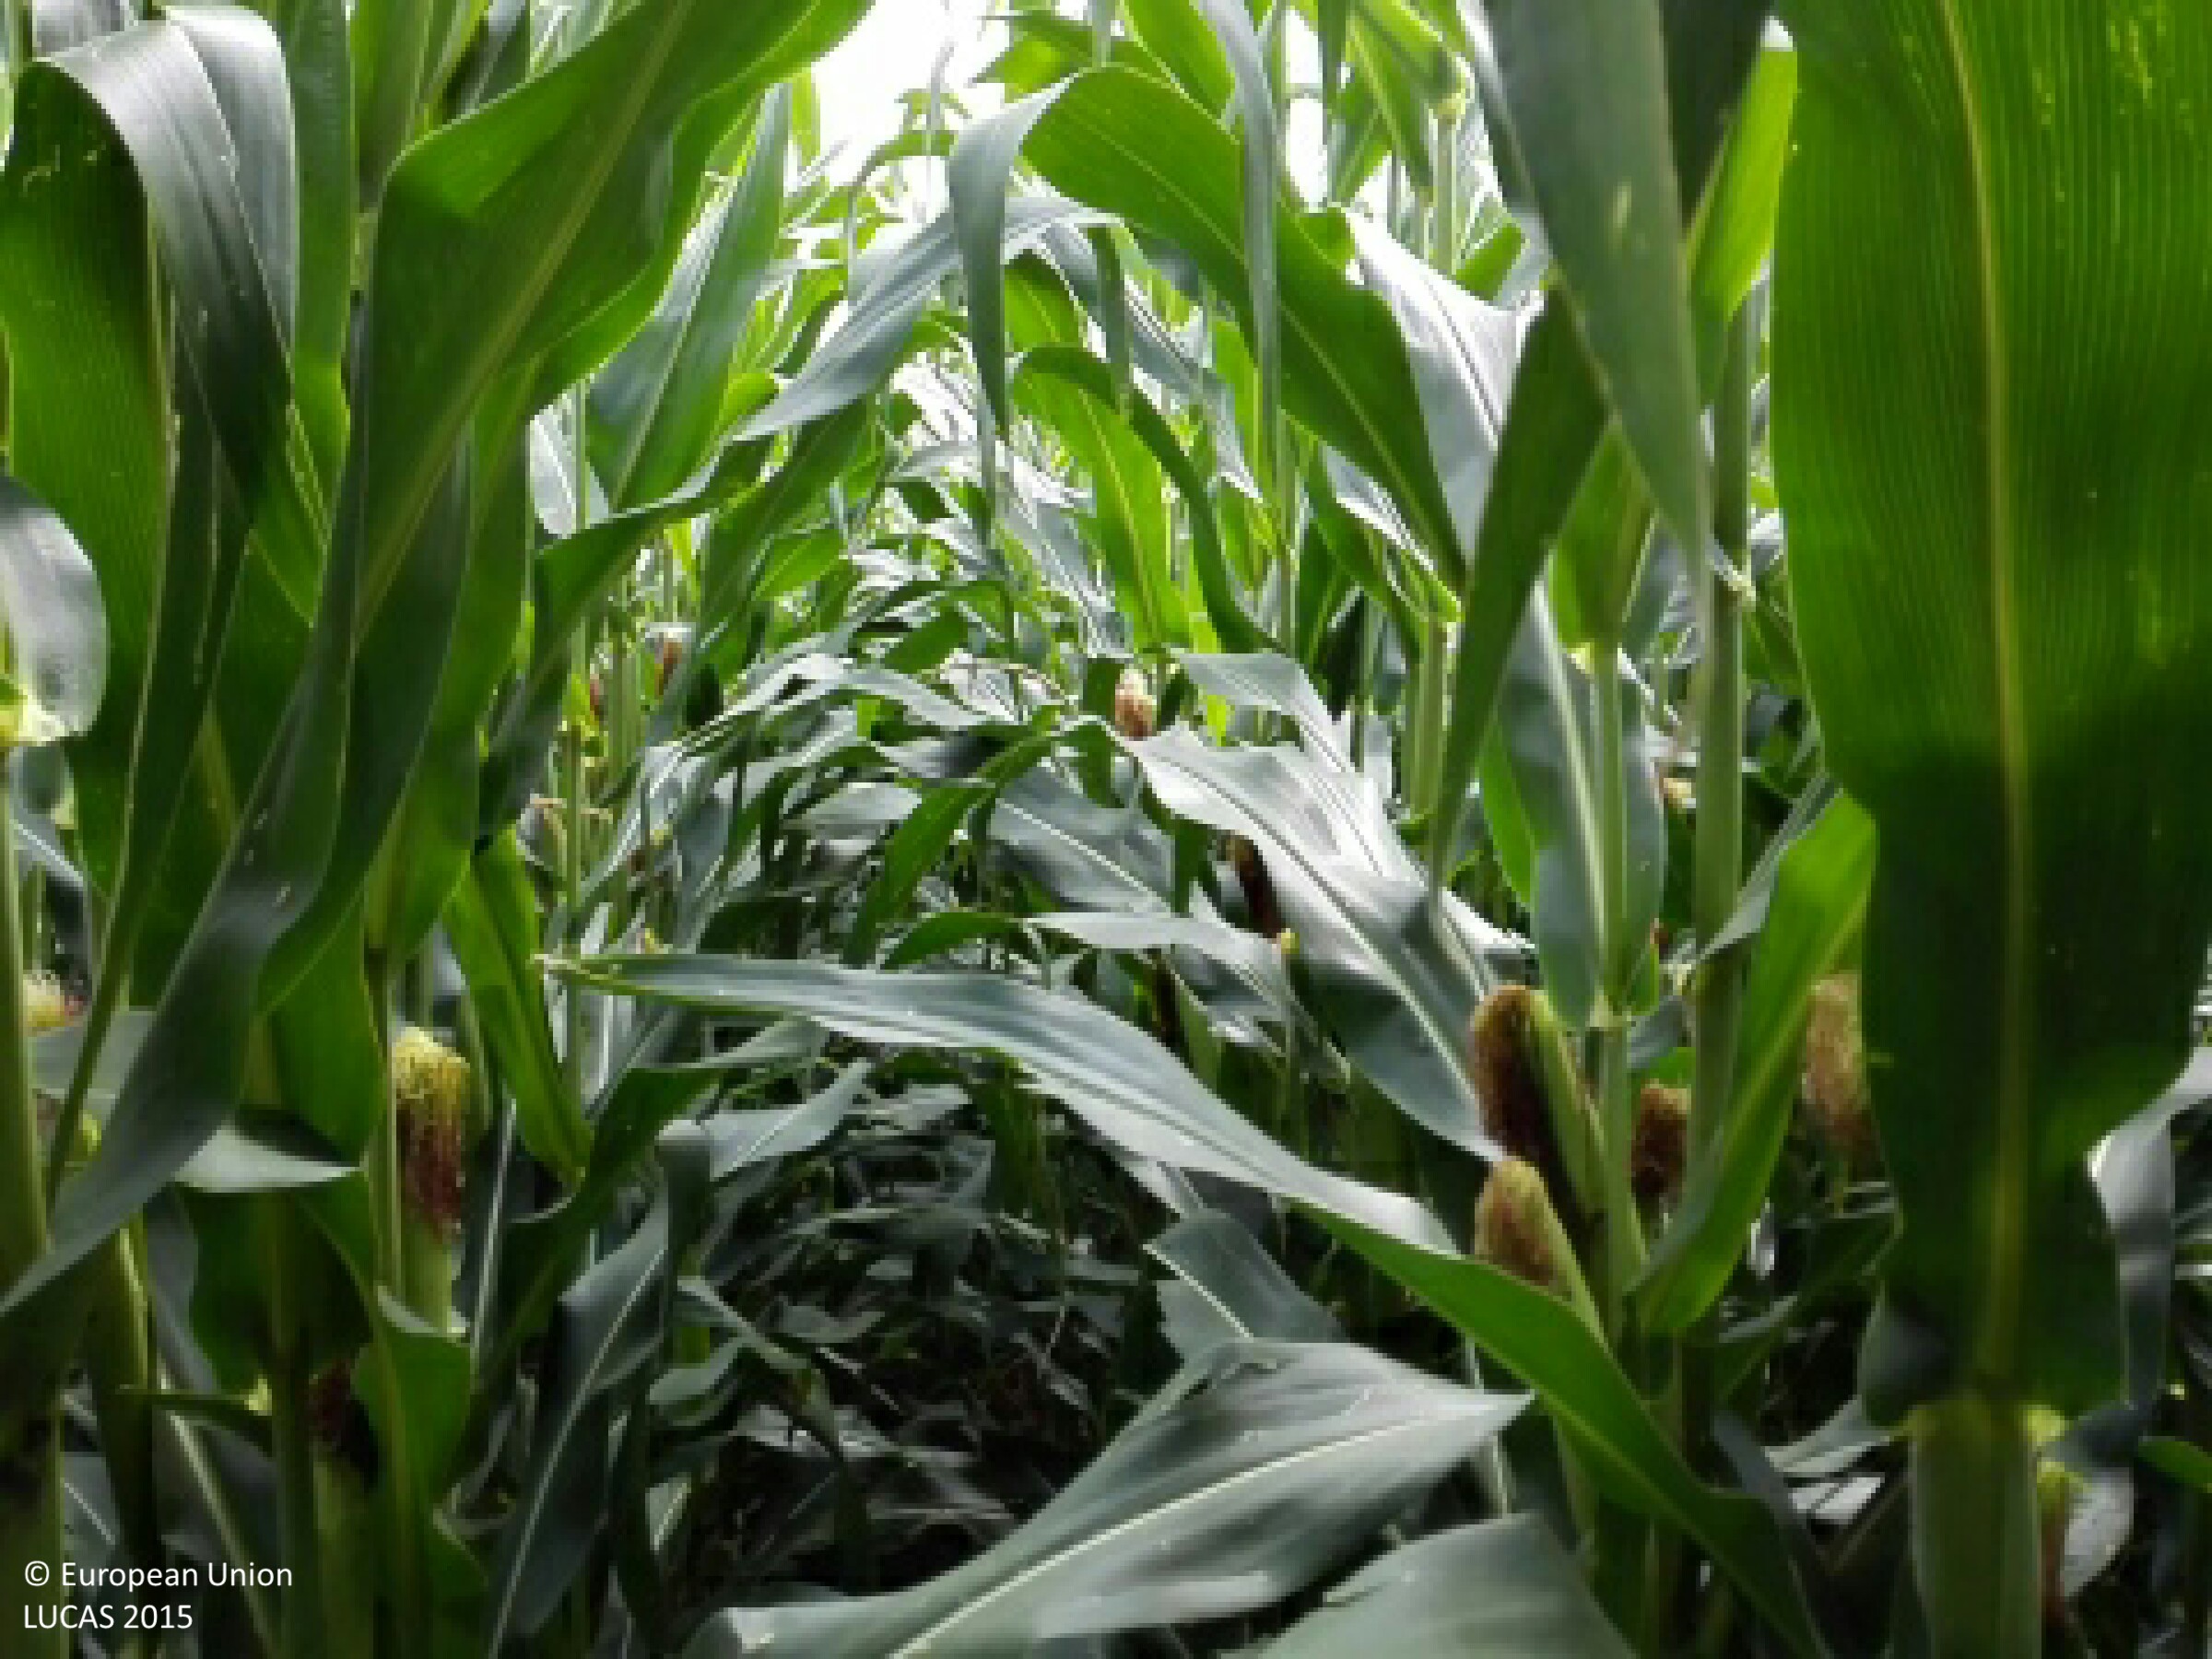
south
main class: Cropland
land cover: Maize
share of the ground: > 75 %
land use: Agriculture (excluding fallow land and kitchen gardens)
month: July
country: HU
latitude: 47.5596
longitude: 21.3781
